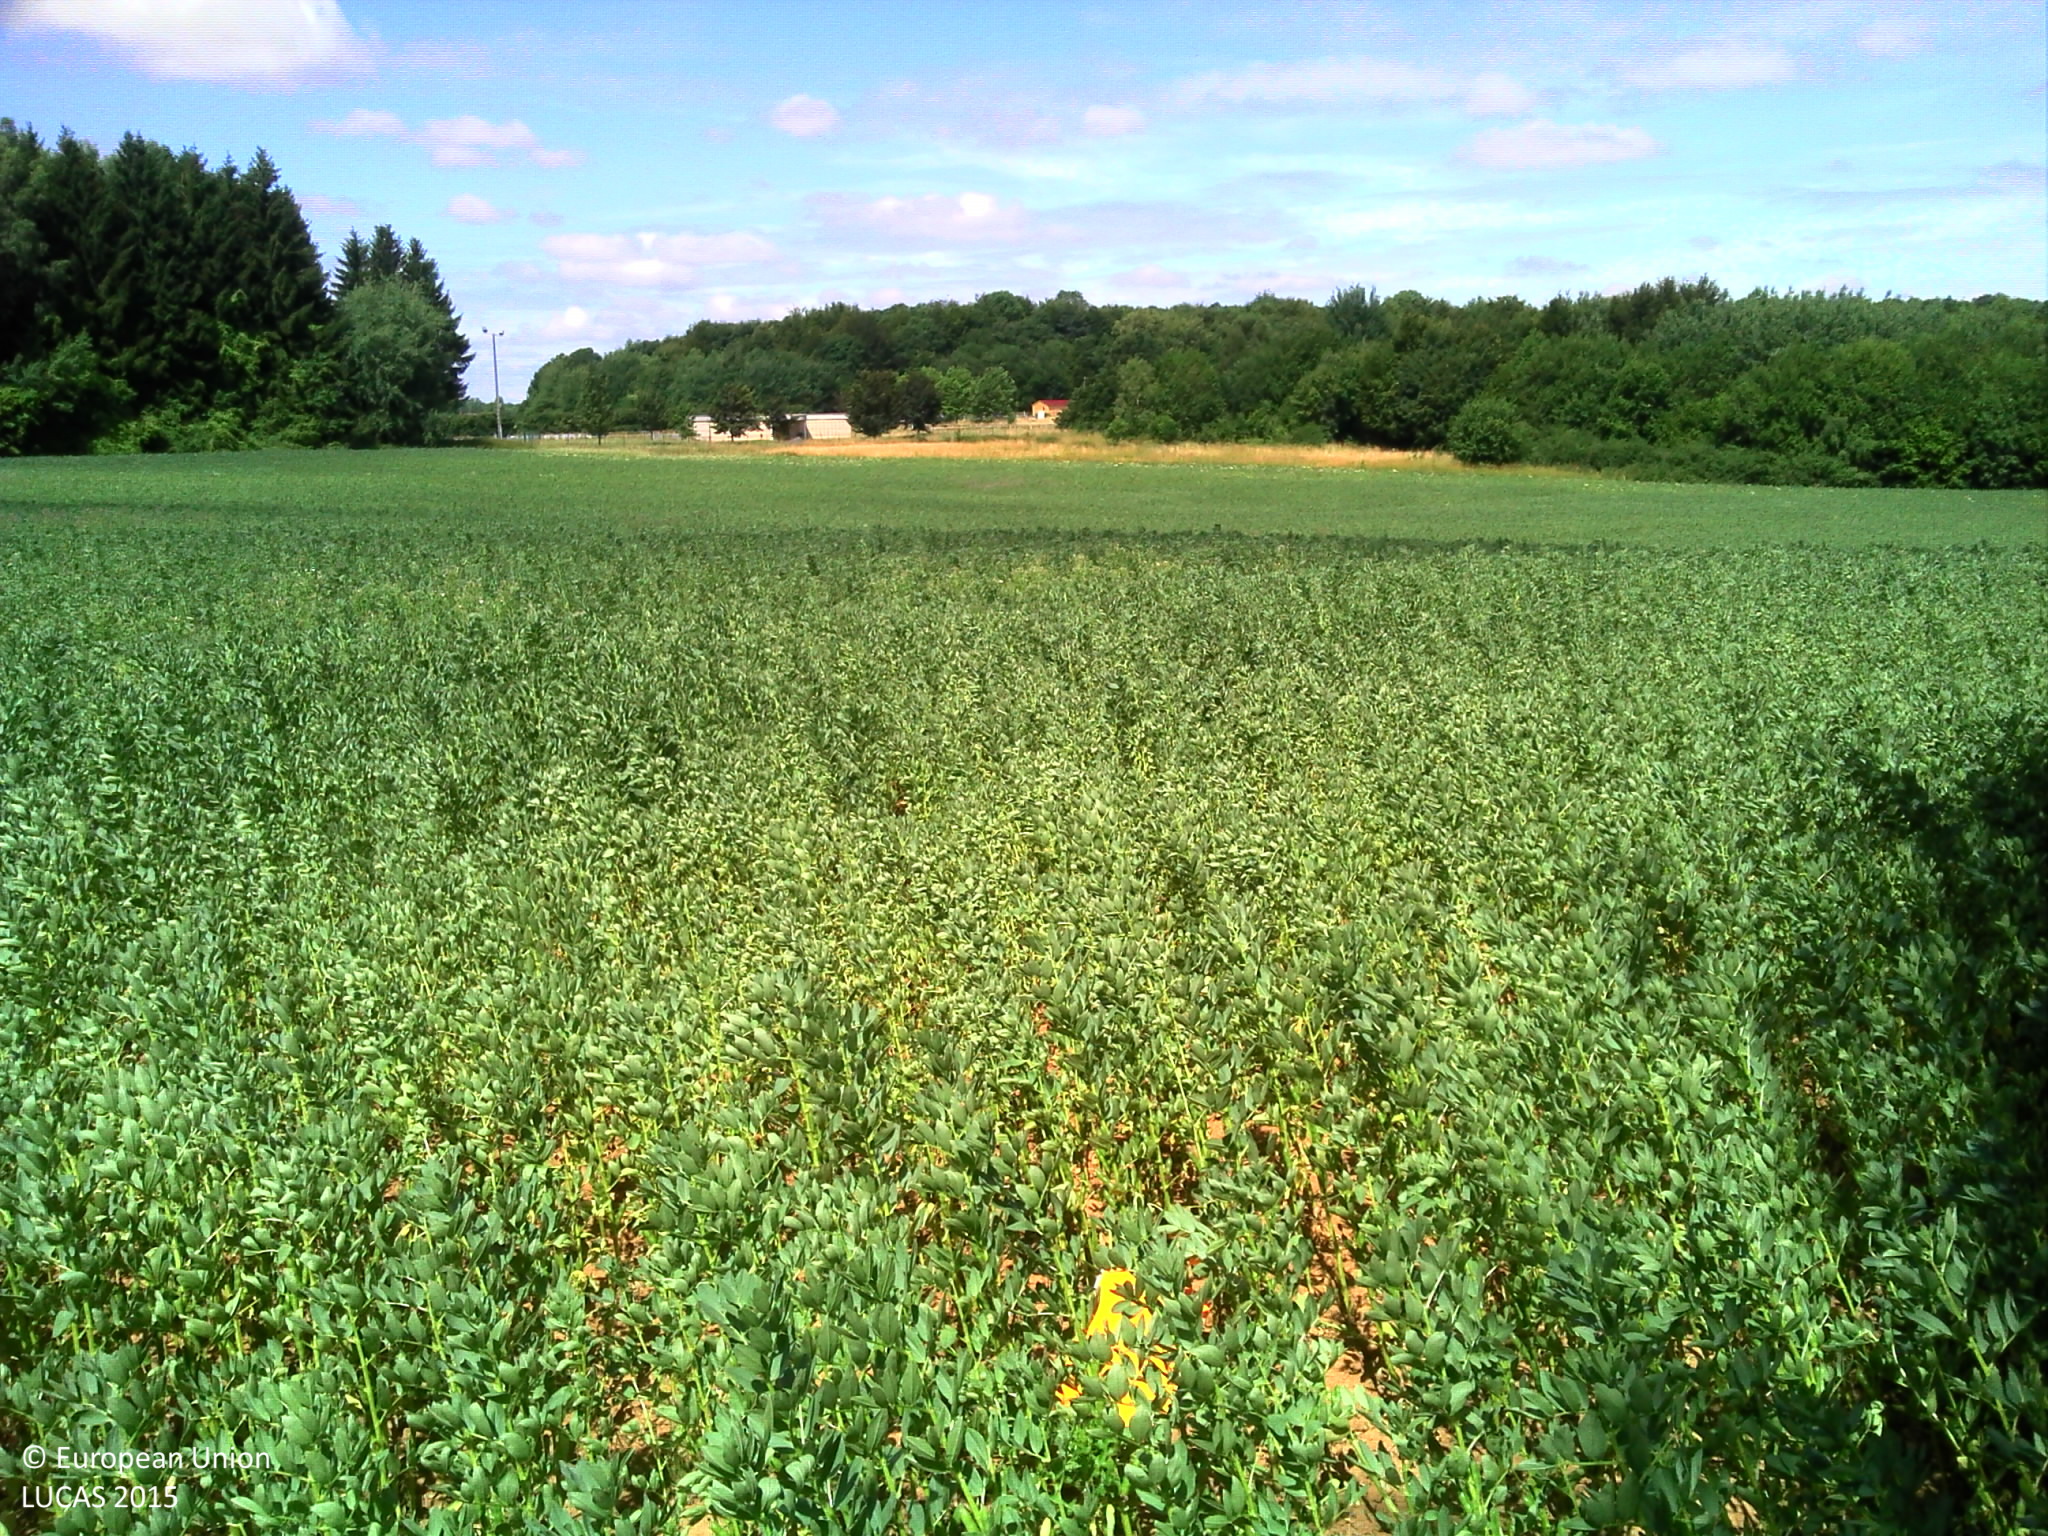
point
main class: Cropland
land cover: Dry pulses
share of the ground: > 75 %
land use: Agriculture (excluding fallow land and kitchen gardens)
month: July
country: FR
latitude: 49.4623
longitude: 5.9014
